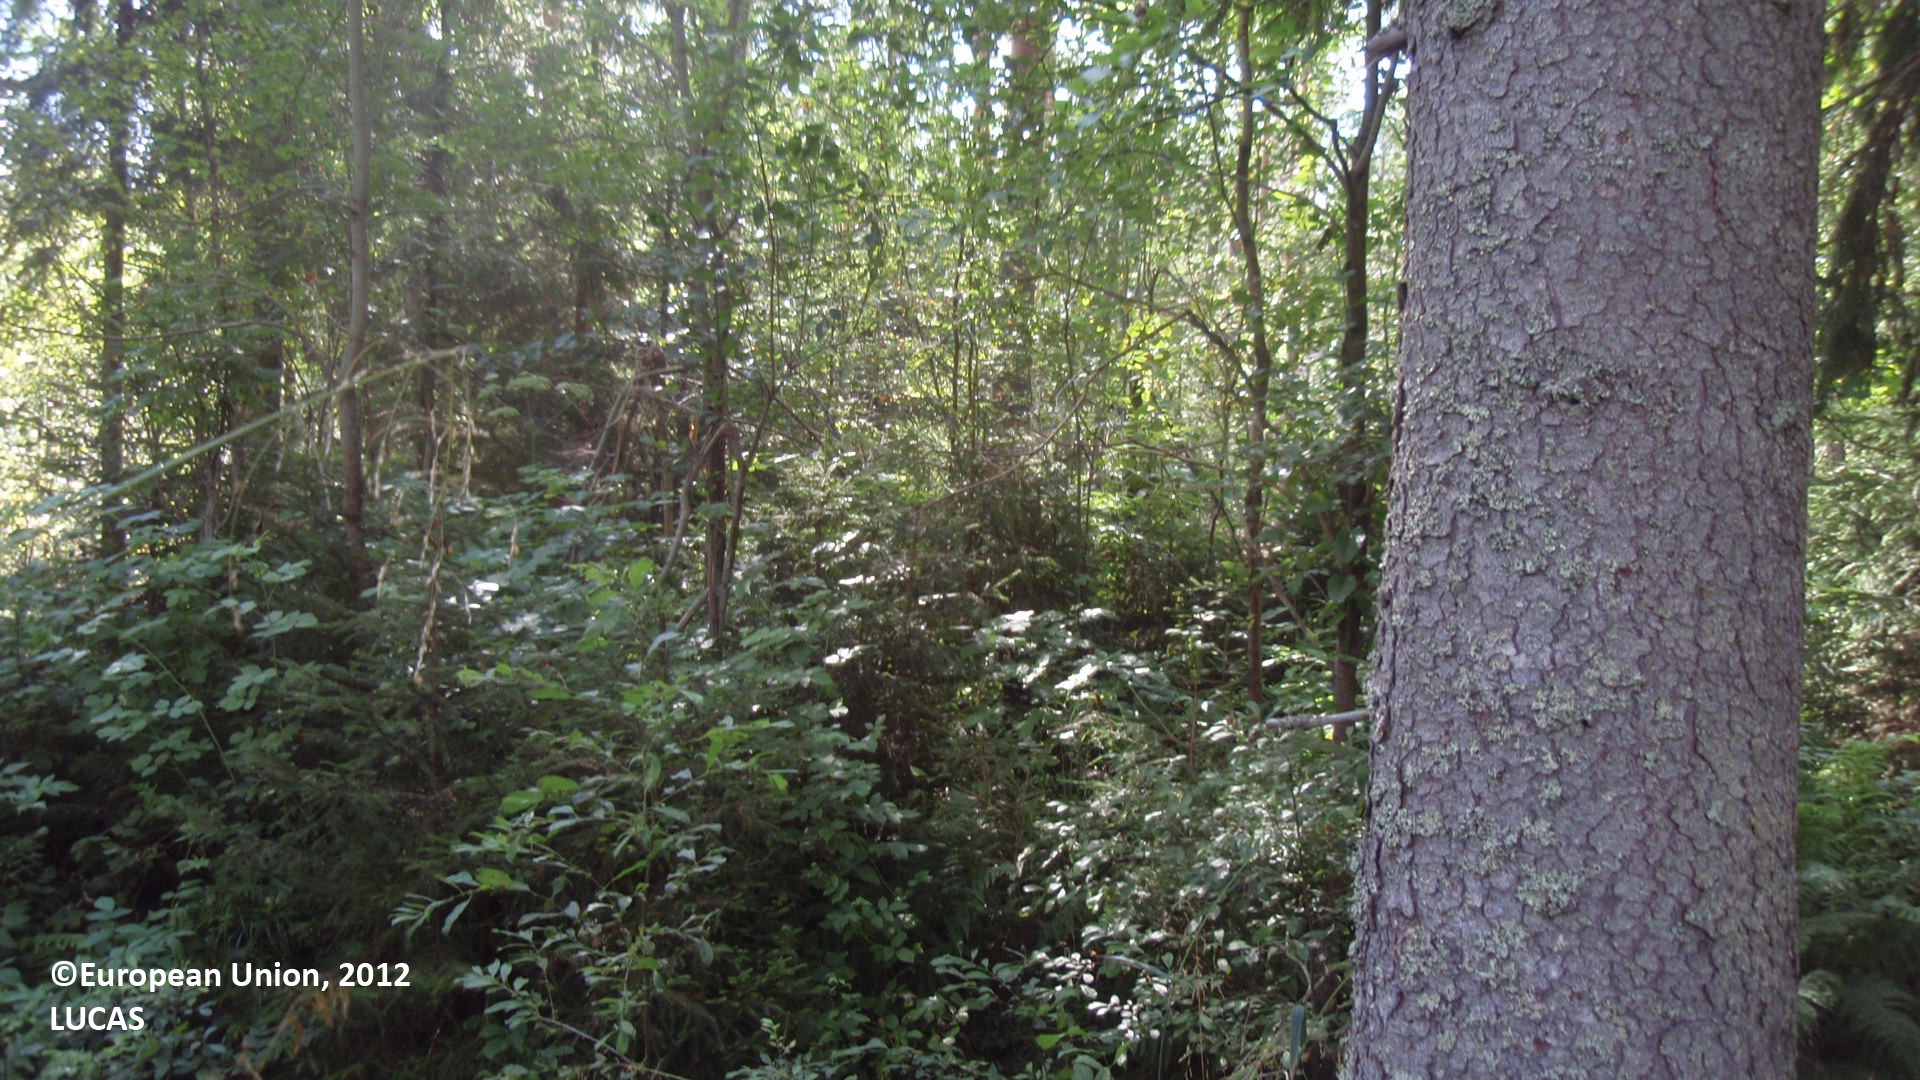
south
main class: Woodland
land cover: Spruce dominated mixed woodland
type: boreal forest
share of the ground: 50 - 75 %
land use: Forestry
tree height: > 5 m
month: August
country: FI
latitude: 60.8020
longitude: 26.6793
